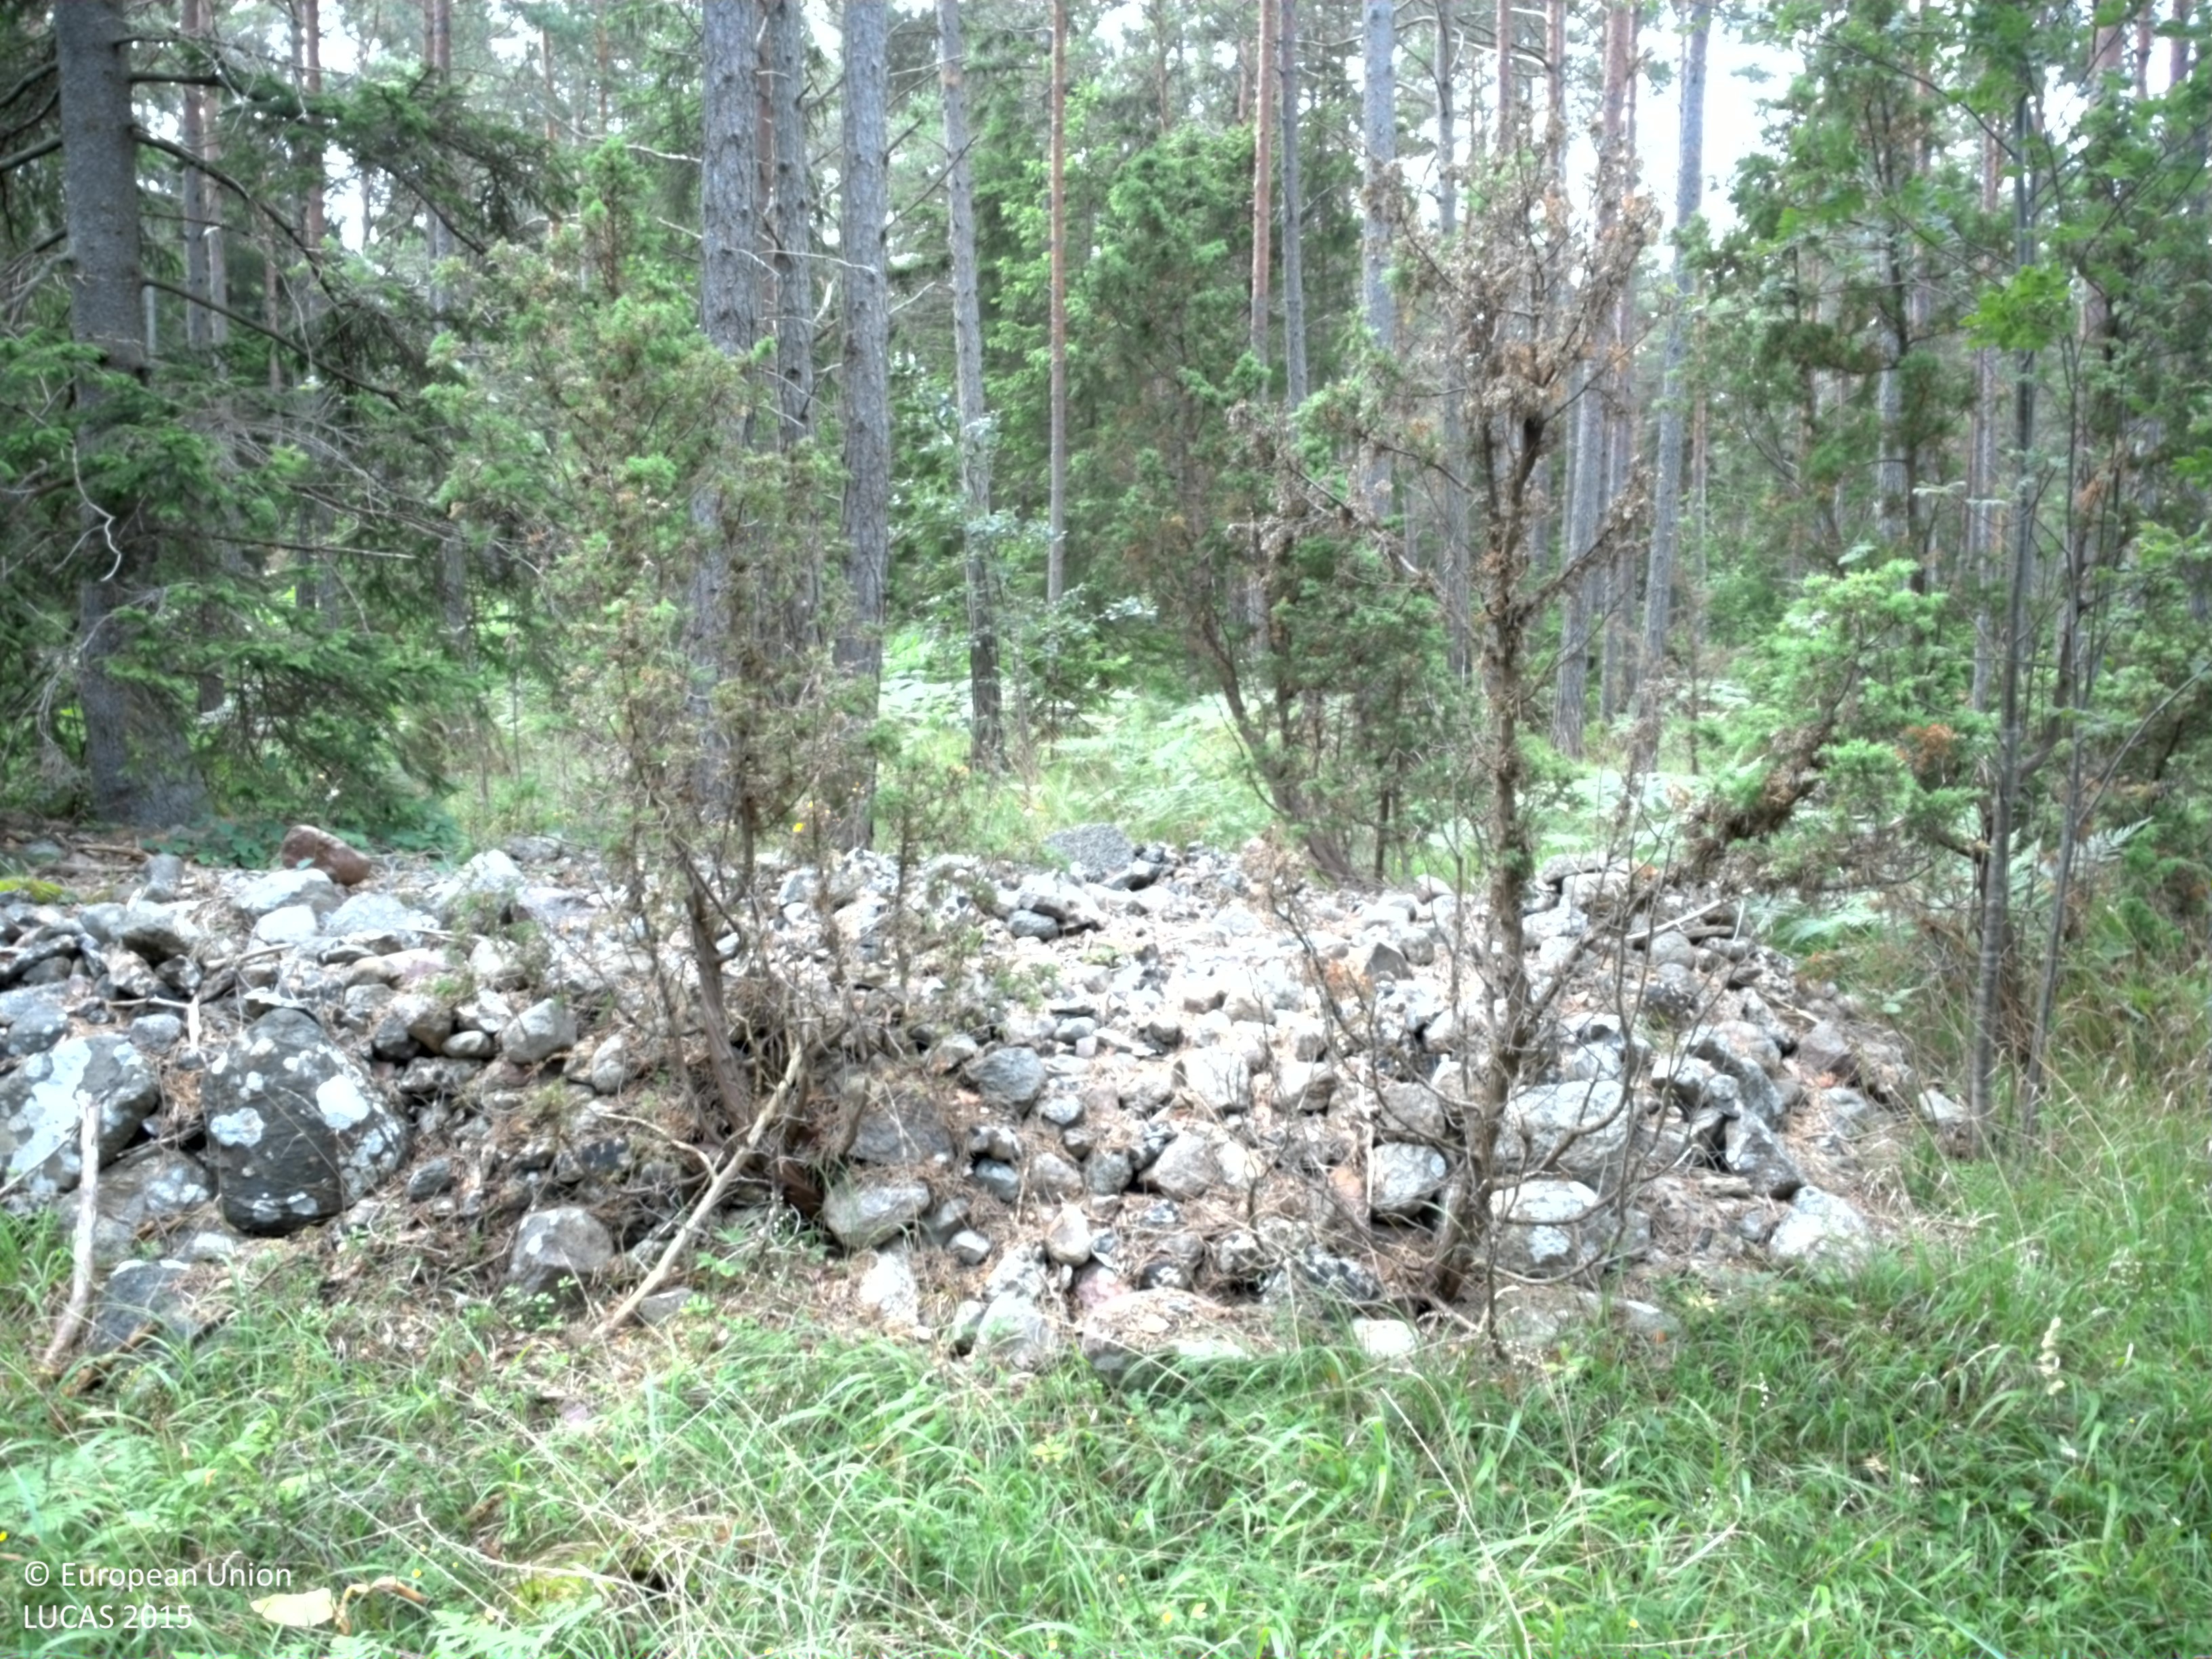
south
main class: Woodland
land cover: Pine dominated coniferous woodland
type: hemiboreal forest and nemoral coniferous forest and mixed broadleaved-coniferous forest
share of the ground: > 75 %
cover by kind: coniferous forest trees 75 %, herbaceous plants 15 %, shrubs 5 %, unconsolidated bare surface 5 %
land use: Forestry
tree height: > 5 m
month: July
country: SE
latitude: 57.5536
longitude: 18.7504
